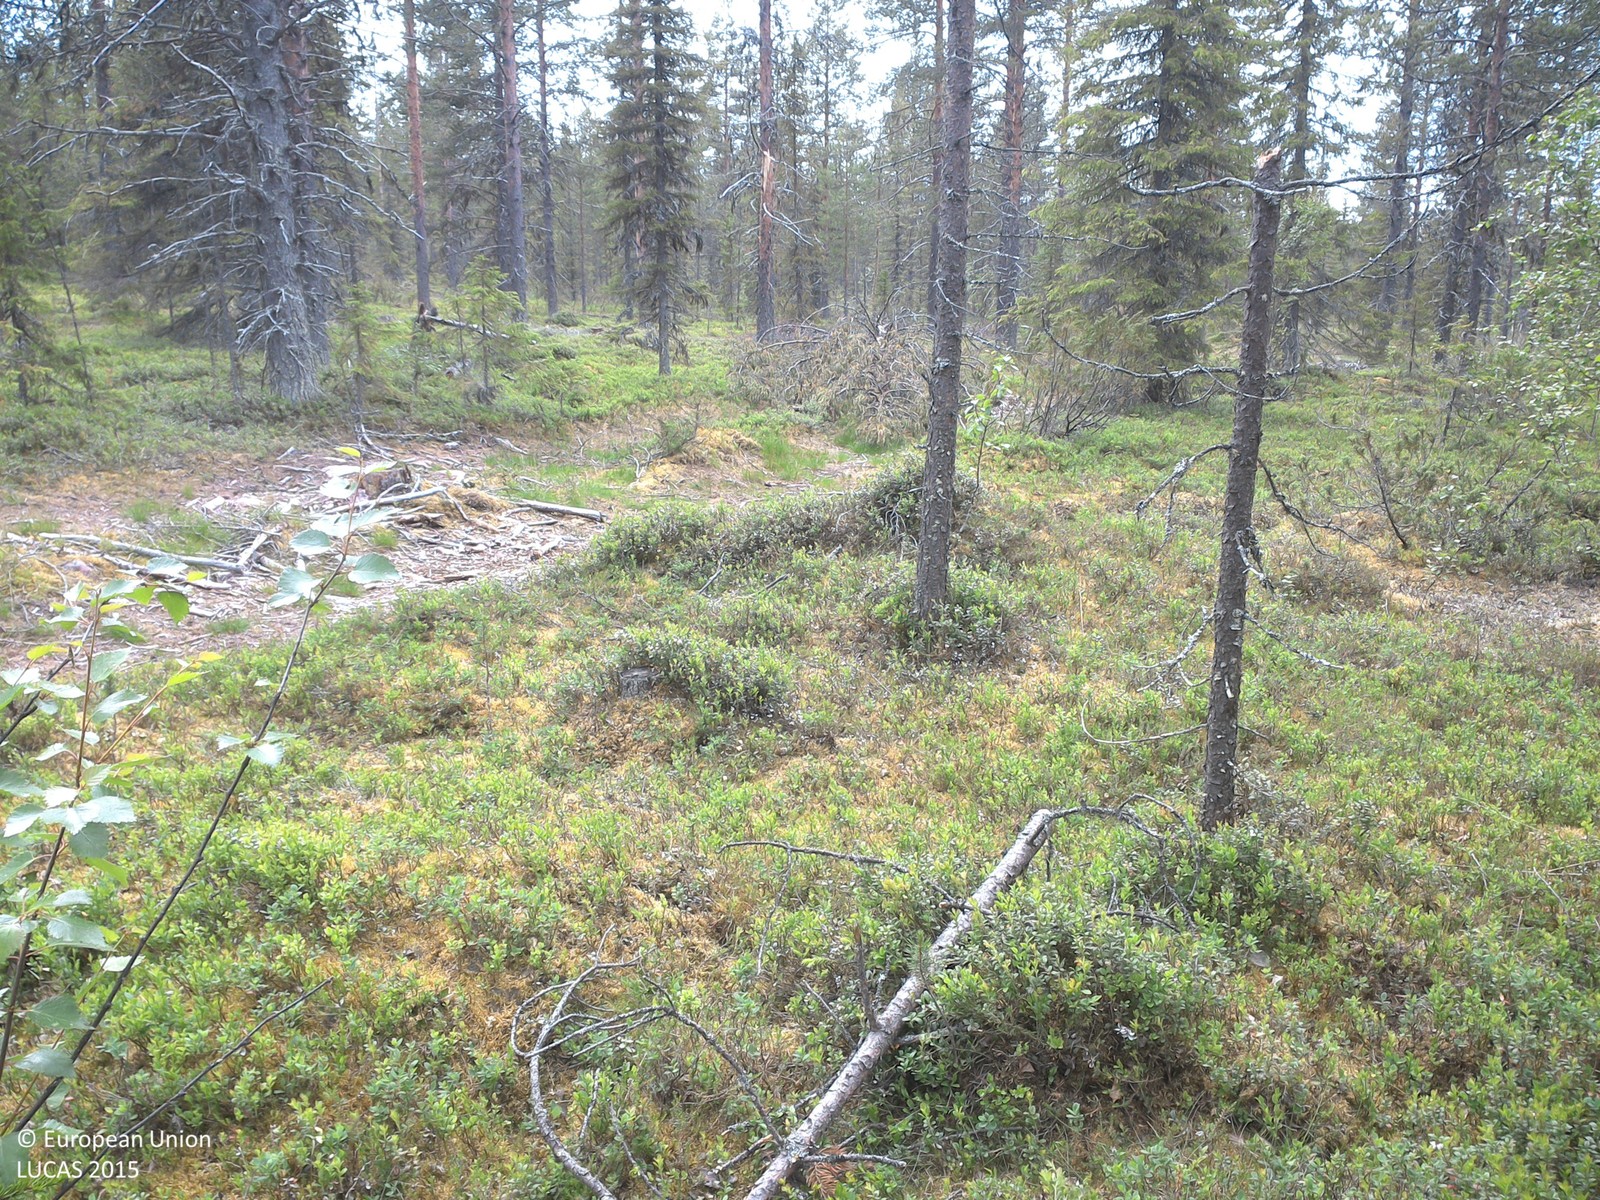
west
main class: Woodland
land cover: Pine dominated coniferous woodland
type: boreal forest
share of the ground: 25 - 50 %
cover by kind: shrubs 50 %, coniferous forest trees 40 %, lichens and mosses 10 %
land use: Forestry
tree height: > 5 m
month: July
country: SE
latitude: 67.5781
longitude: 22.7159
